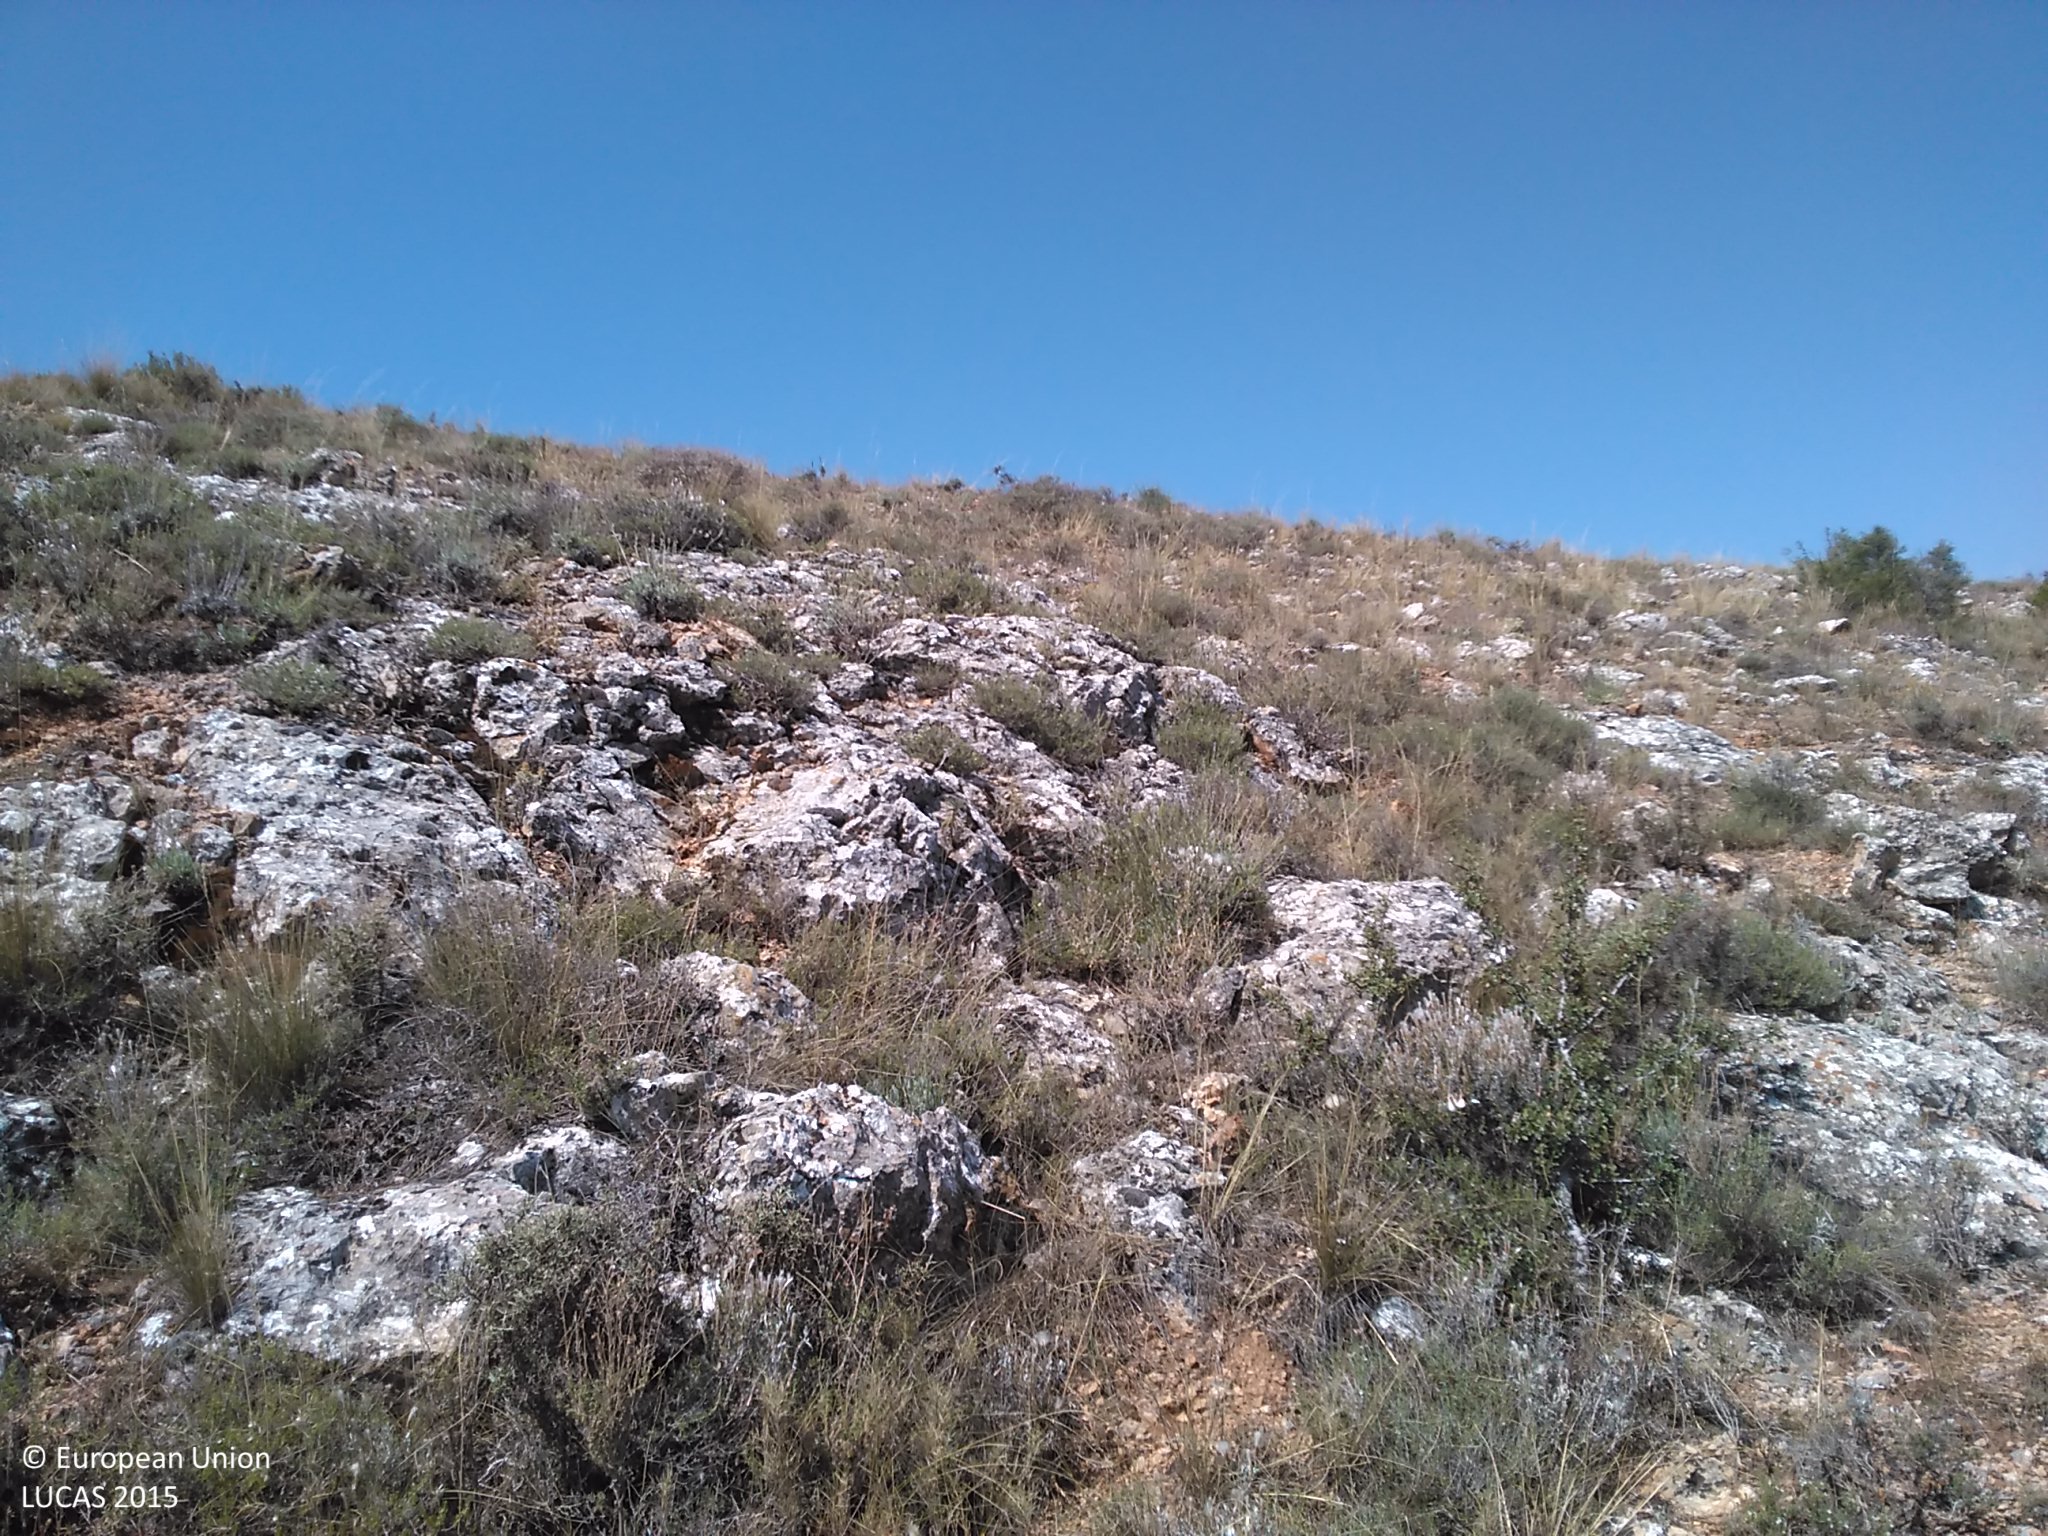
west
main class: Shrubland
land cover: Shrubland without tree cover
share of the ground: 25 - 50 %
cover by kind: shrubs 40 %, consolidated bare surface 25 %, unconsolidated bare surface 25 %, herbaceous plants 5 %, lichens and mosses 5 %
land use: Semi-natural and natural areas not in use
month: July
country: ES
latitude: 41.5117
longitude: -1.9031
